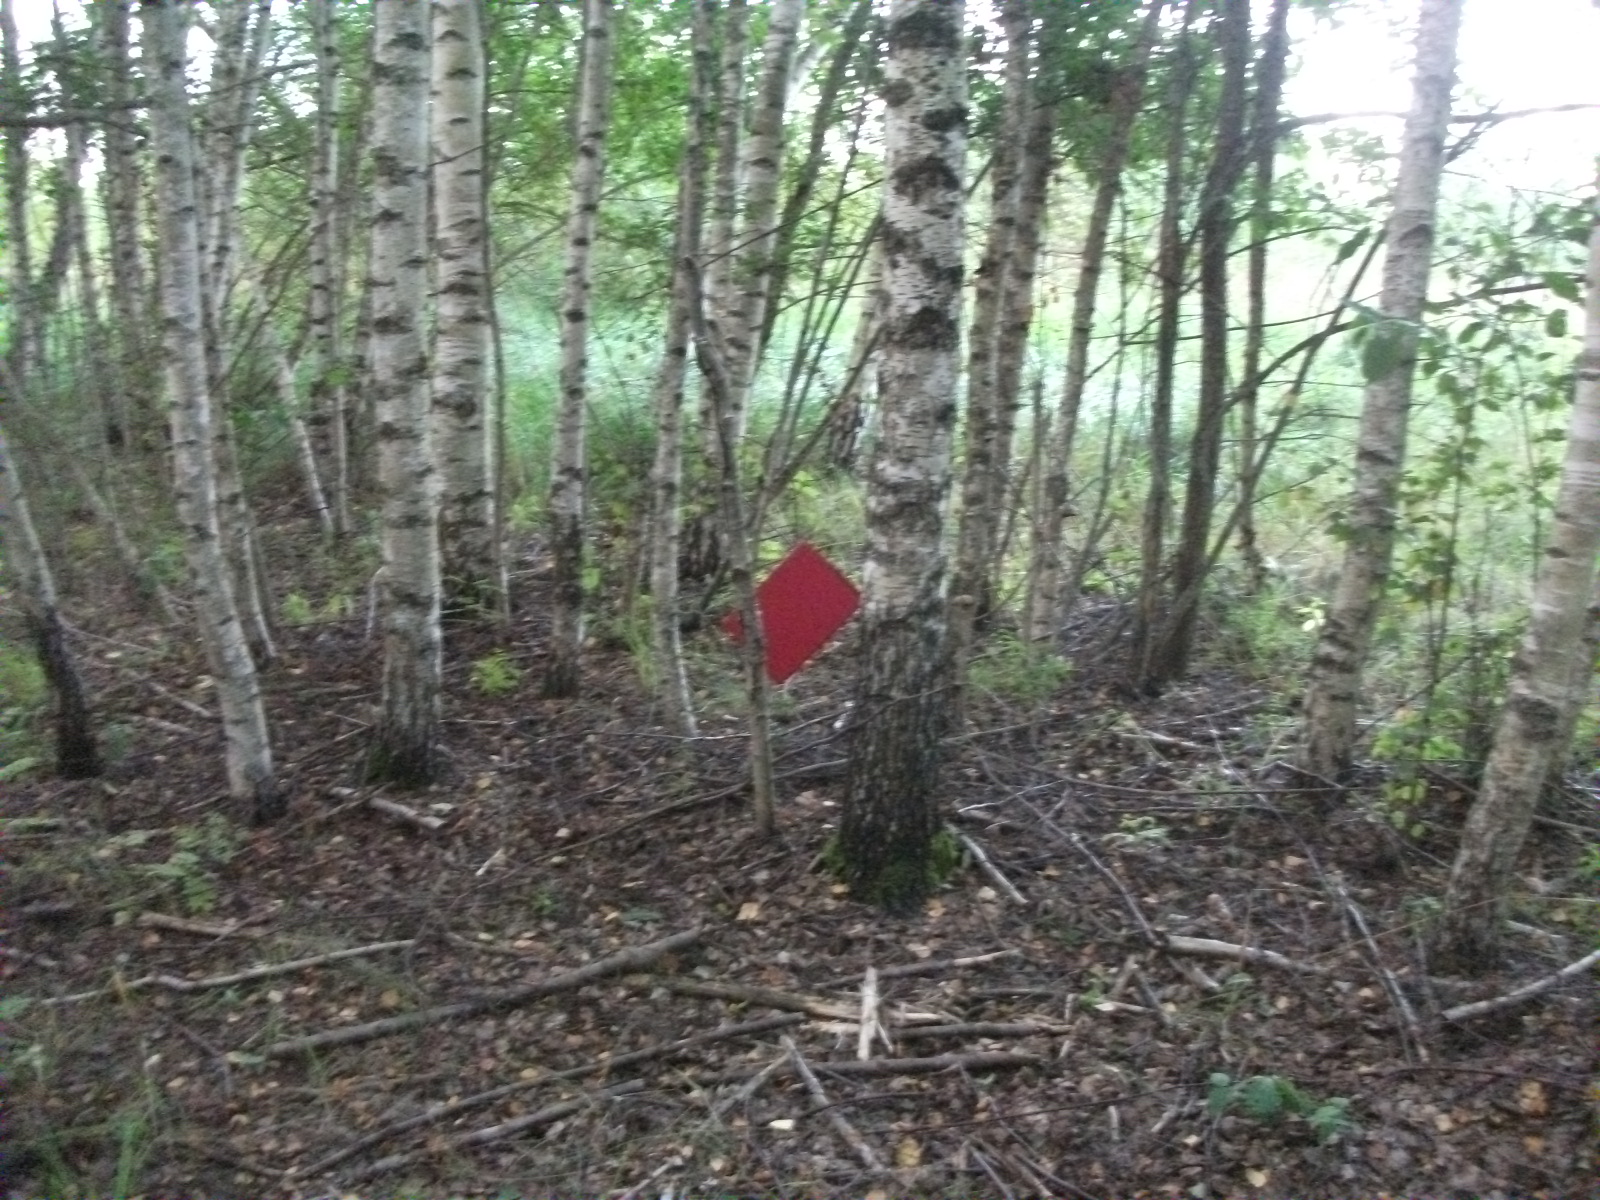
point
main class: Woodland
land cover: Broadleaved woodland
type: non-riverine alder, birch or aspen forest
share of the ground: > 75 %
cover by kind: broadleaved forest trees 80 %, unconsolidated bare surface 10 %, herbaceous plants 5 %
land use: Forestry
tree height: > 5 m
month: August
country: LV
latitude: 56.7662
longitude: 26.4901
